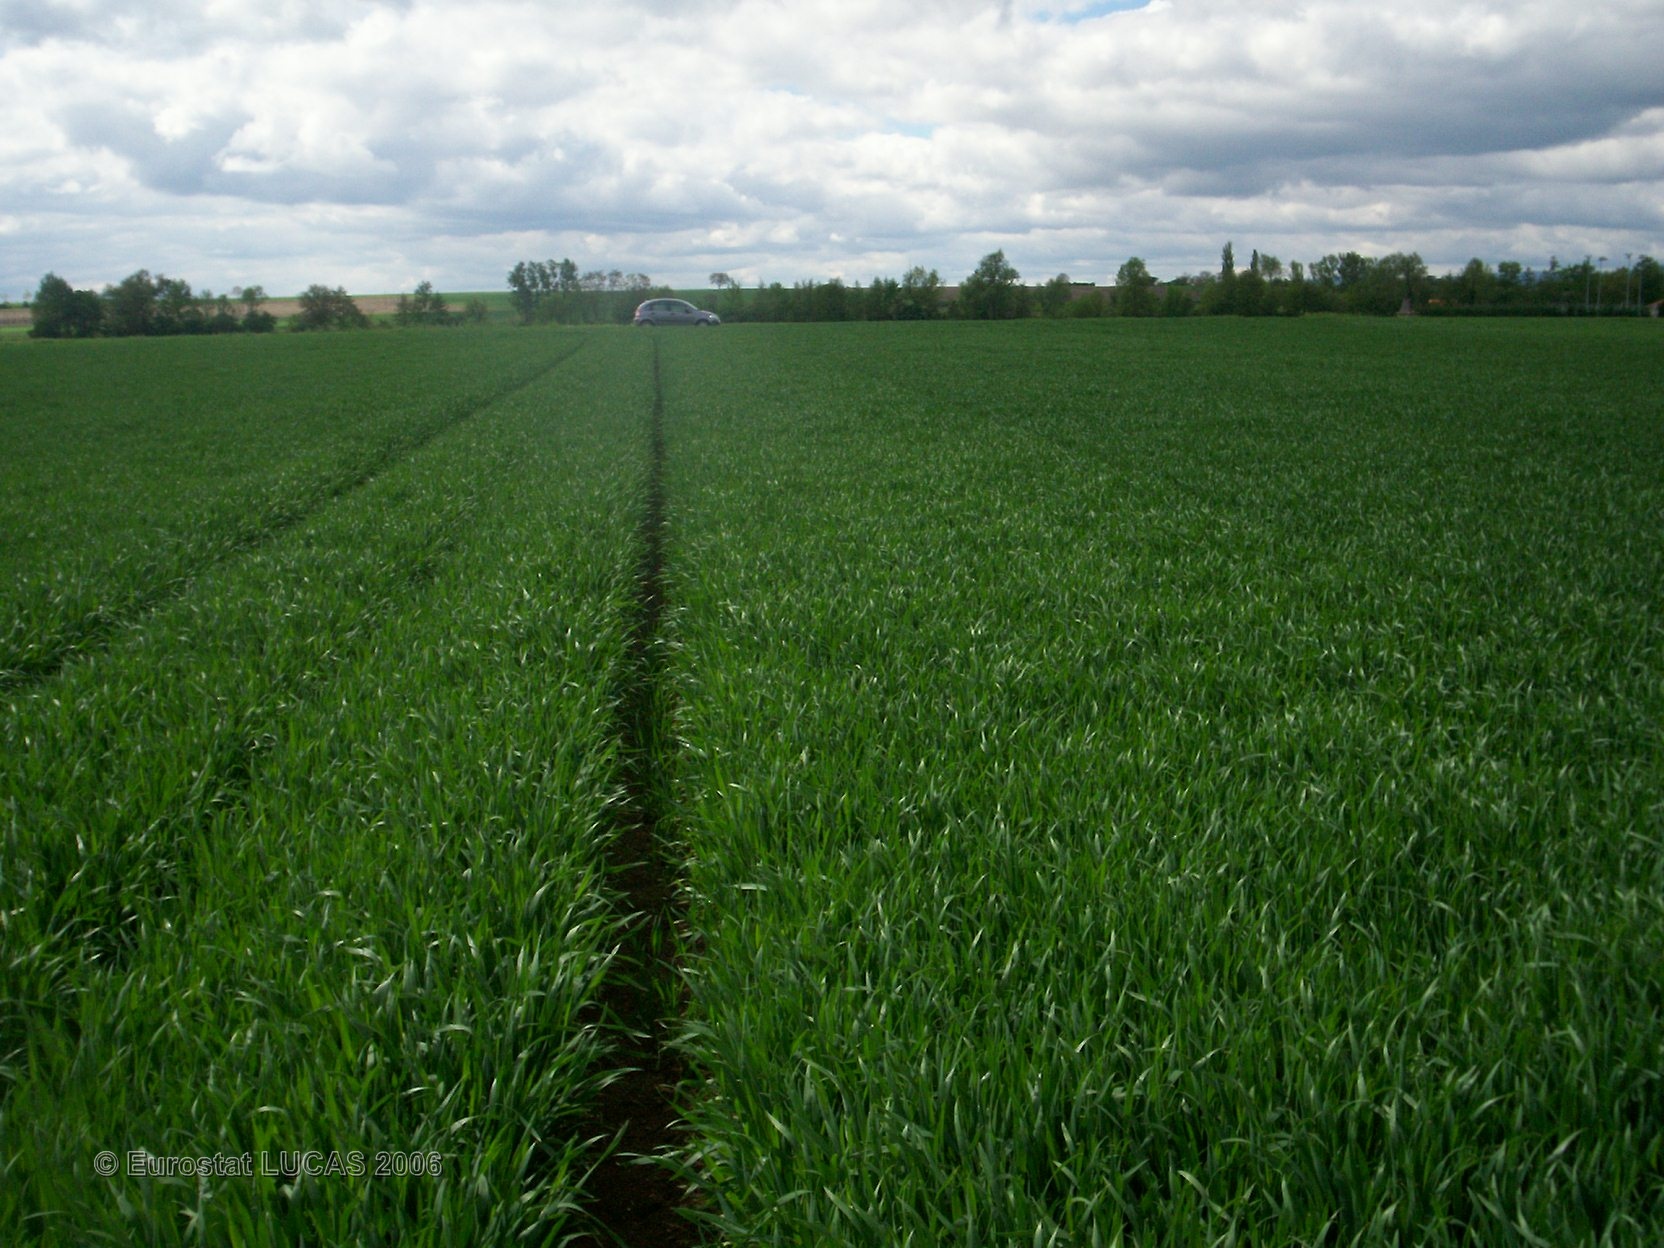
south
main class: Cropland
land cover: Common wheat
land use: Agriculture (excluding fallow land and kitchen gardens)
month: May
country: FR
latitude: 45.9507
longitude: 3.1489
